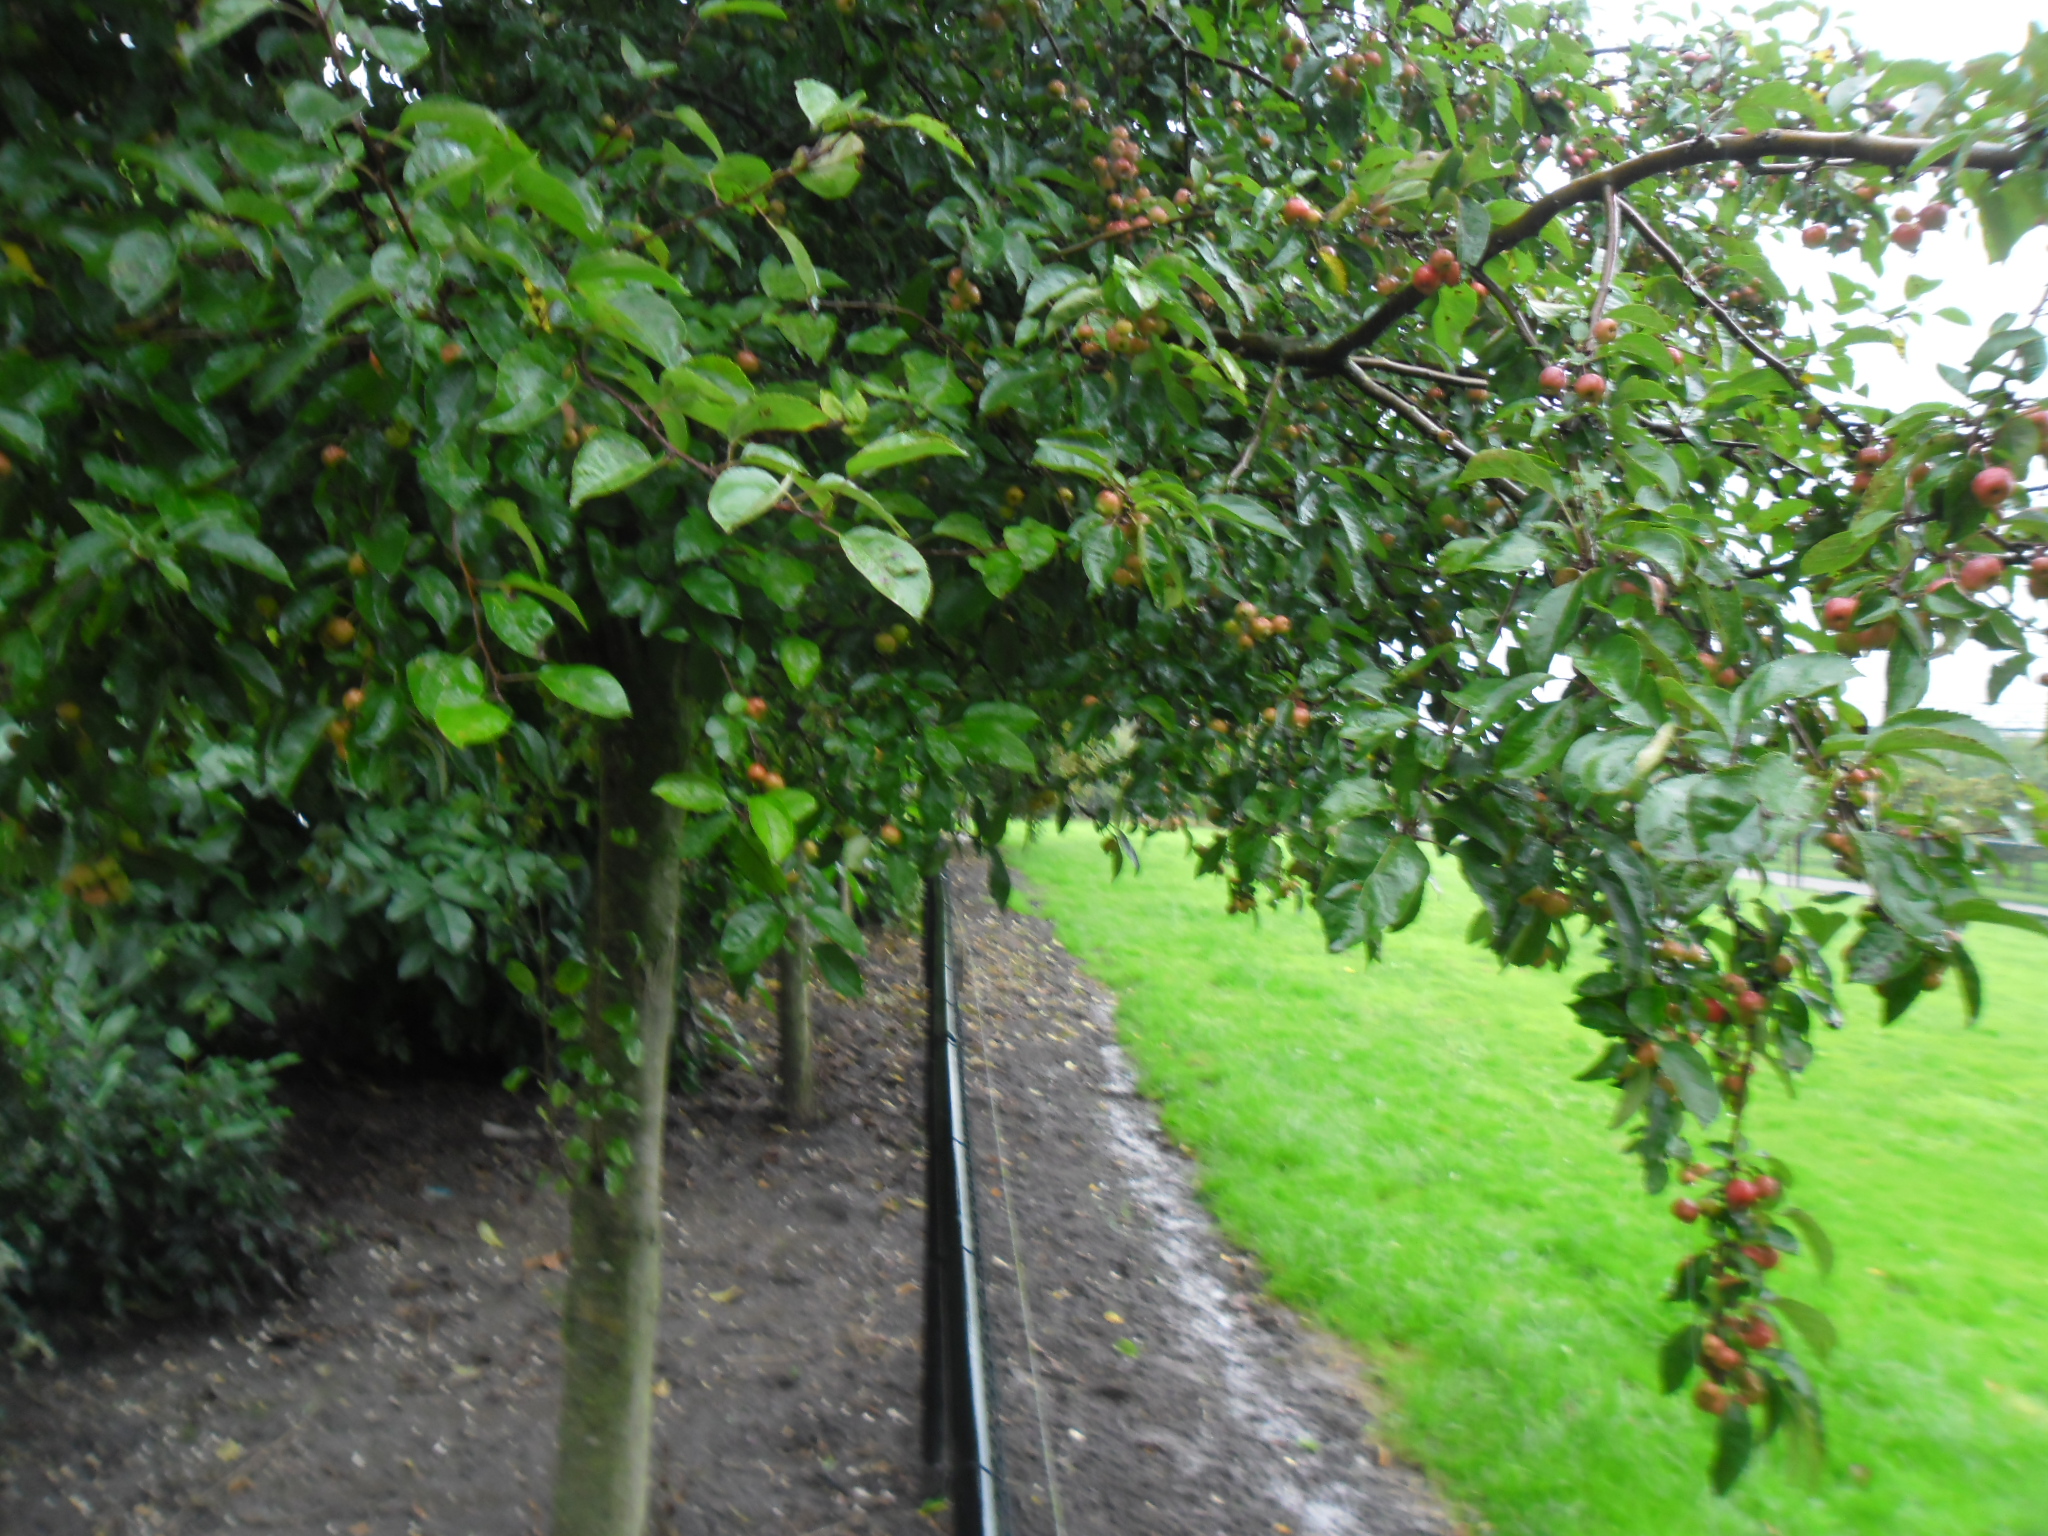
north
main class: Grassland
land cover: Grassland with sparse tree/shrub cover
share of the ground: > 75 %
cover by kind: herbaceous plants 95 %, broadleaved forest trees 5 %
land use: Residential
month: September
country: NL
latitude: 51.9513
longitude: 5.5315
